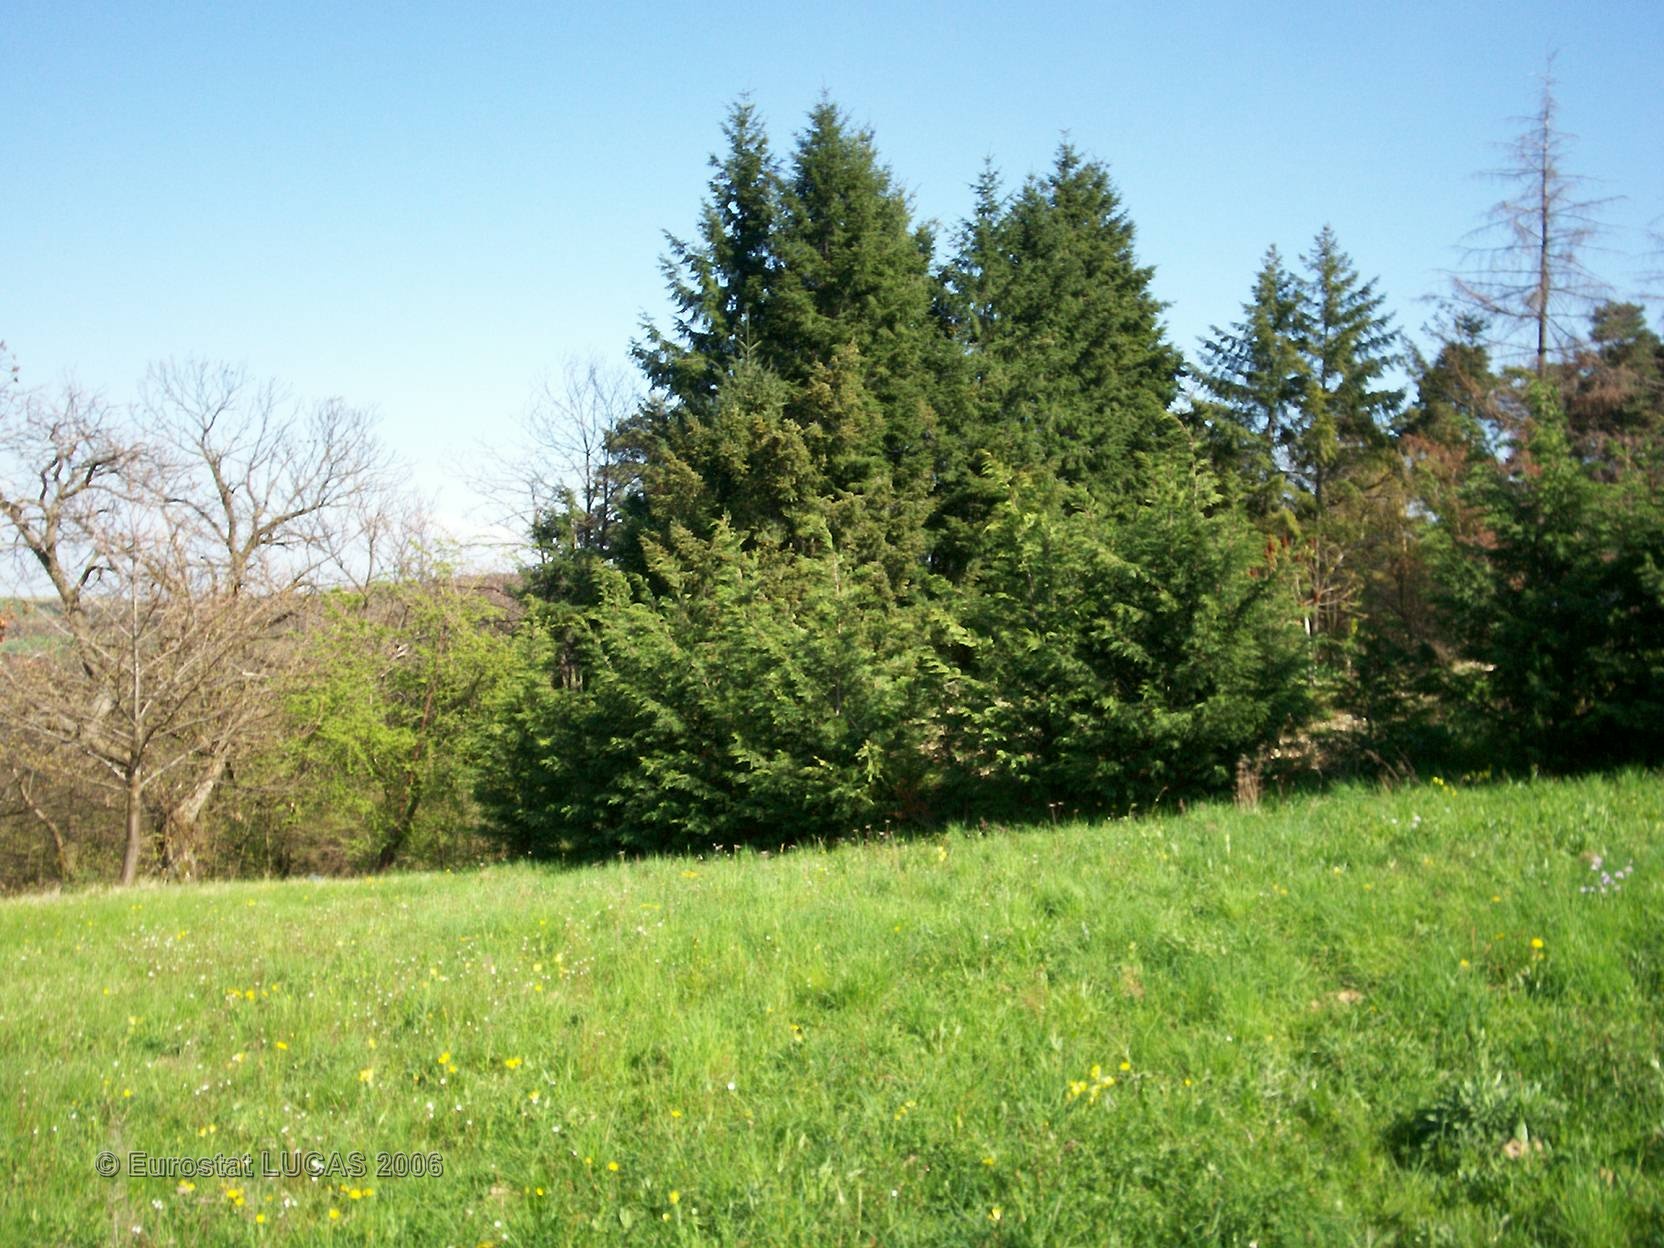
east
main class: Grassland
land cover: Grassland without tree/shrub cover
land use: Agriculture (excluding fallow land and kitchen gardens)
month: April
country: FR
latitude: 45.5384
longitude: 4.7919
